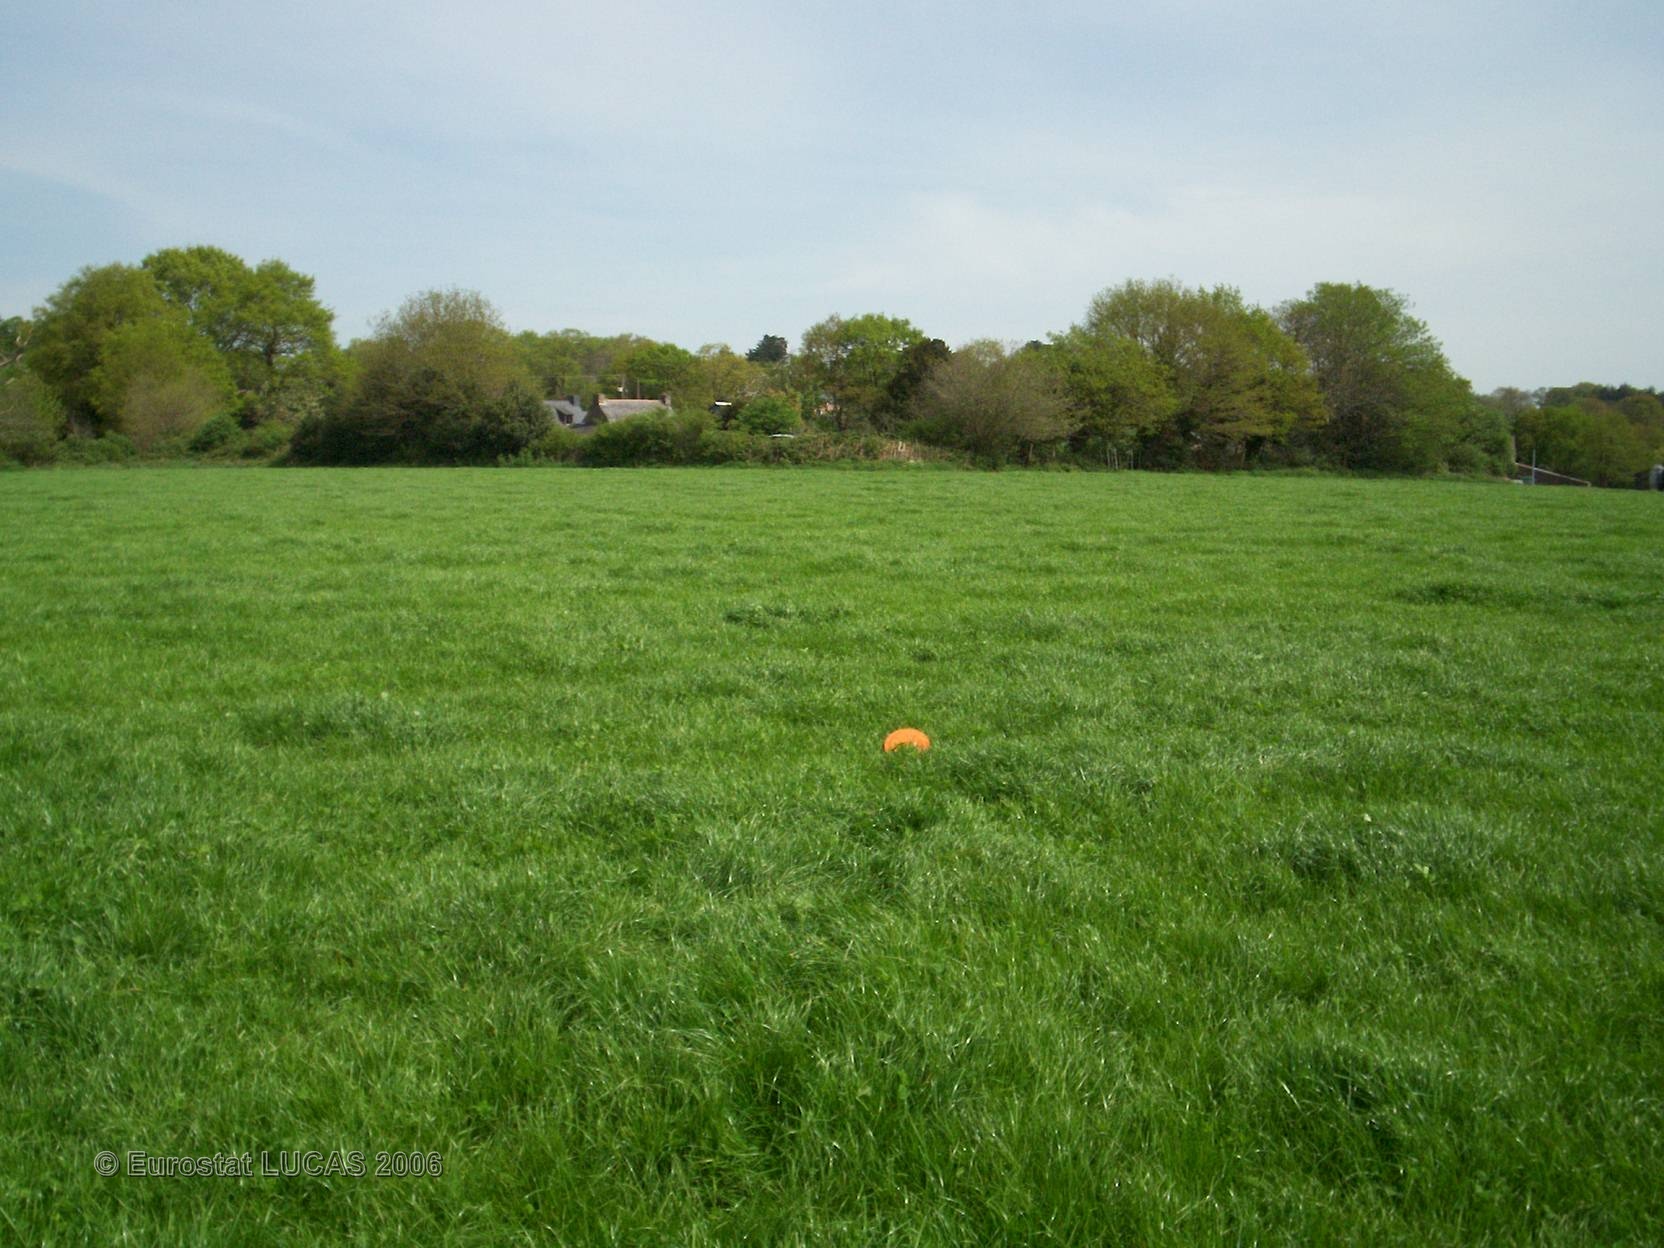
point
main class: Grassland
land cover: Grassland without tree/shrub cover
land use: Agriculture (excluding fallow land and kitchen gardens)
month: May
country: FR
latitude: 47.7132
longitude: -2.3046
